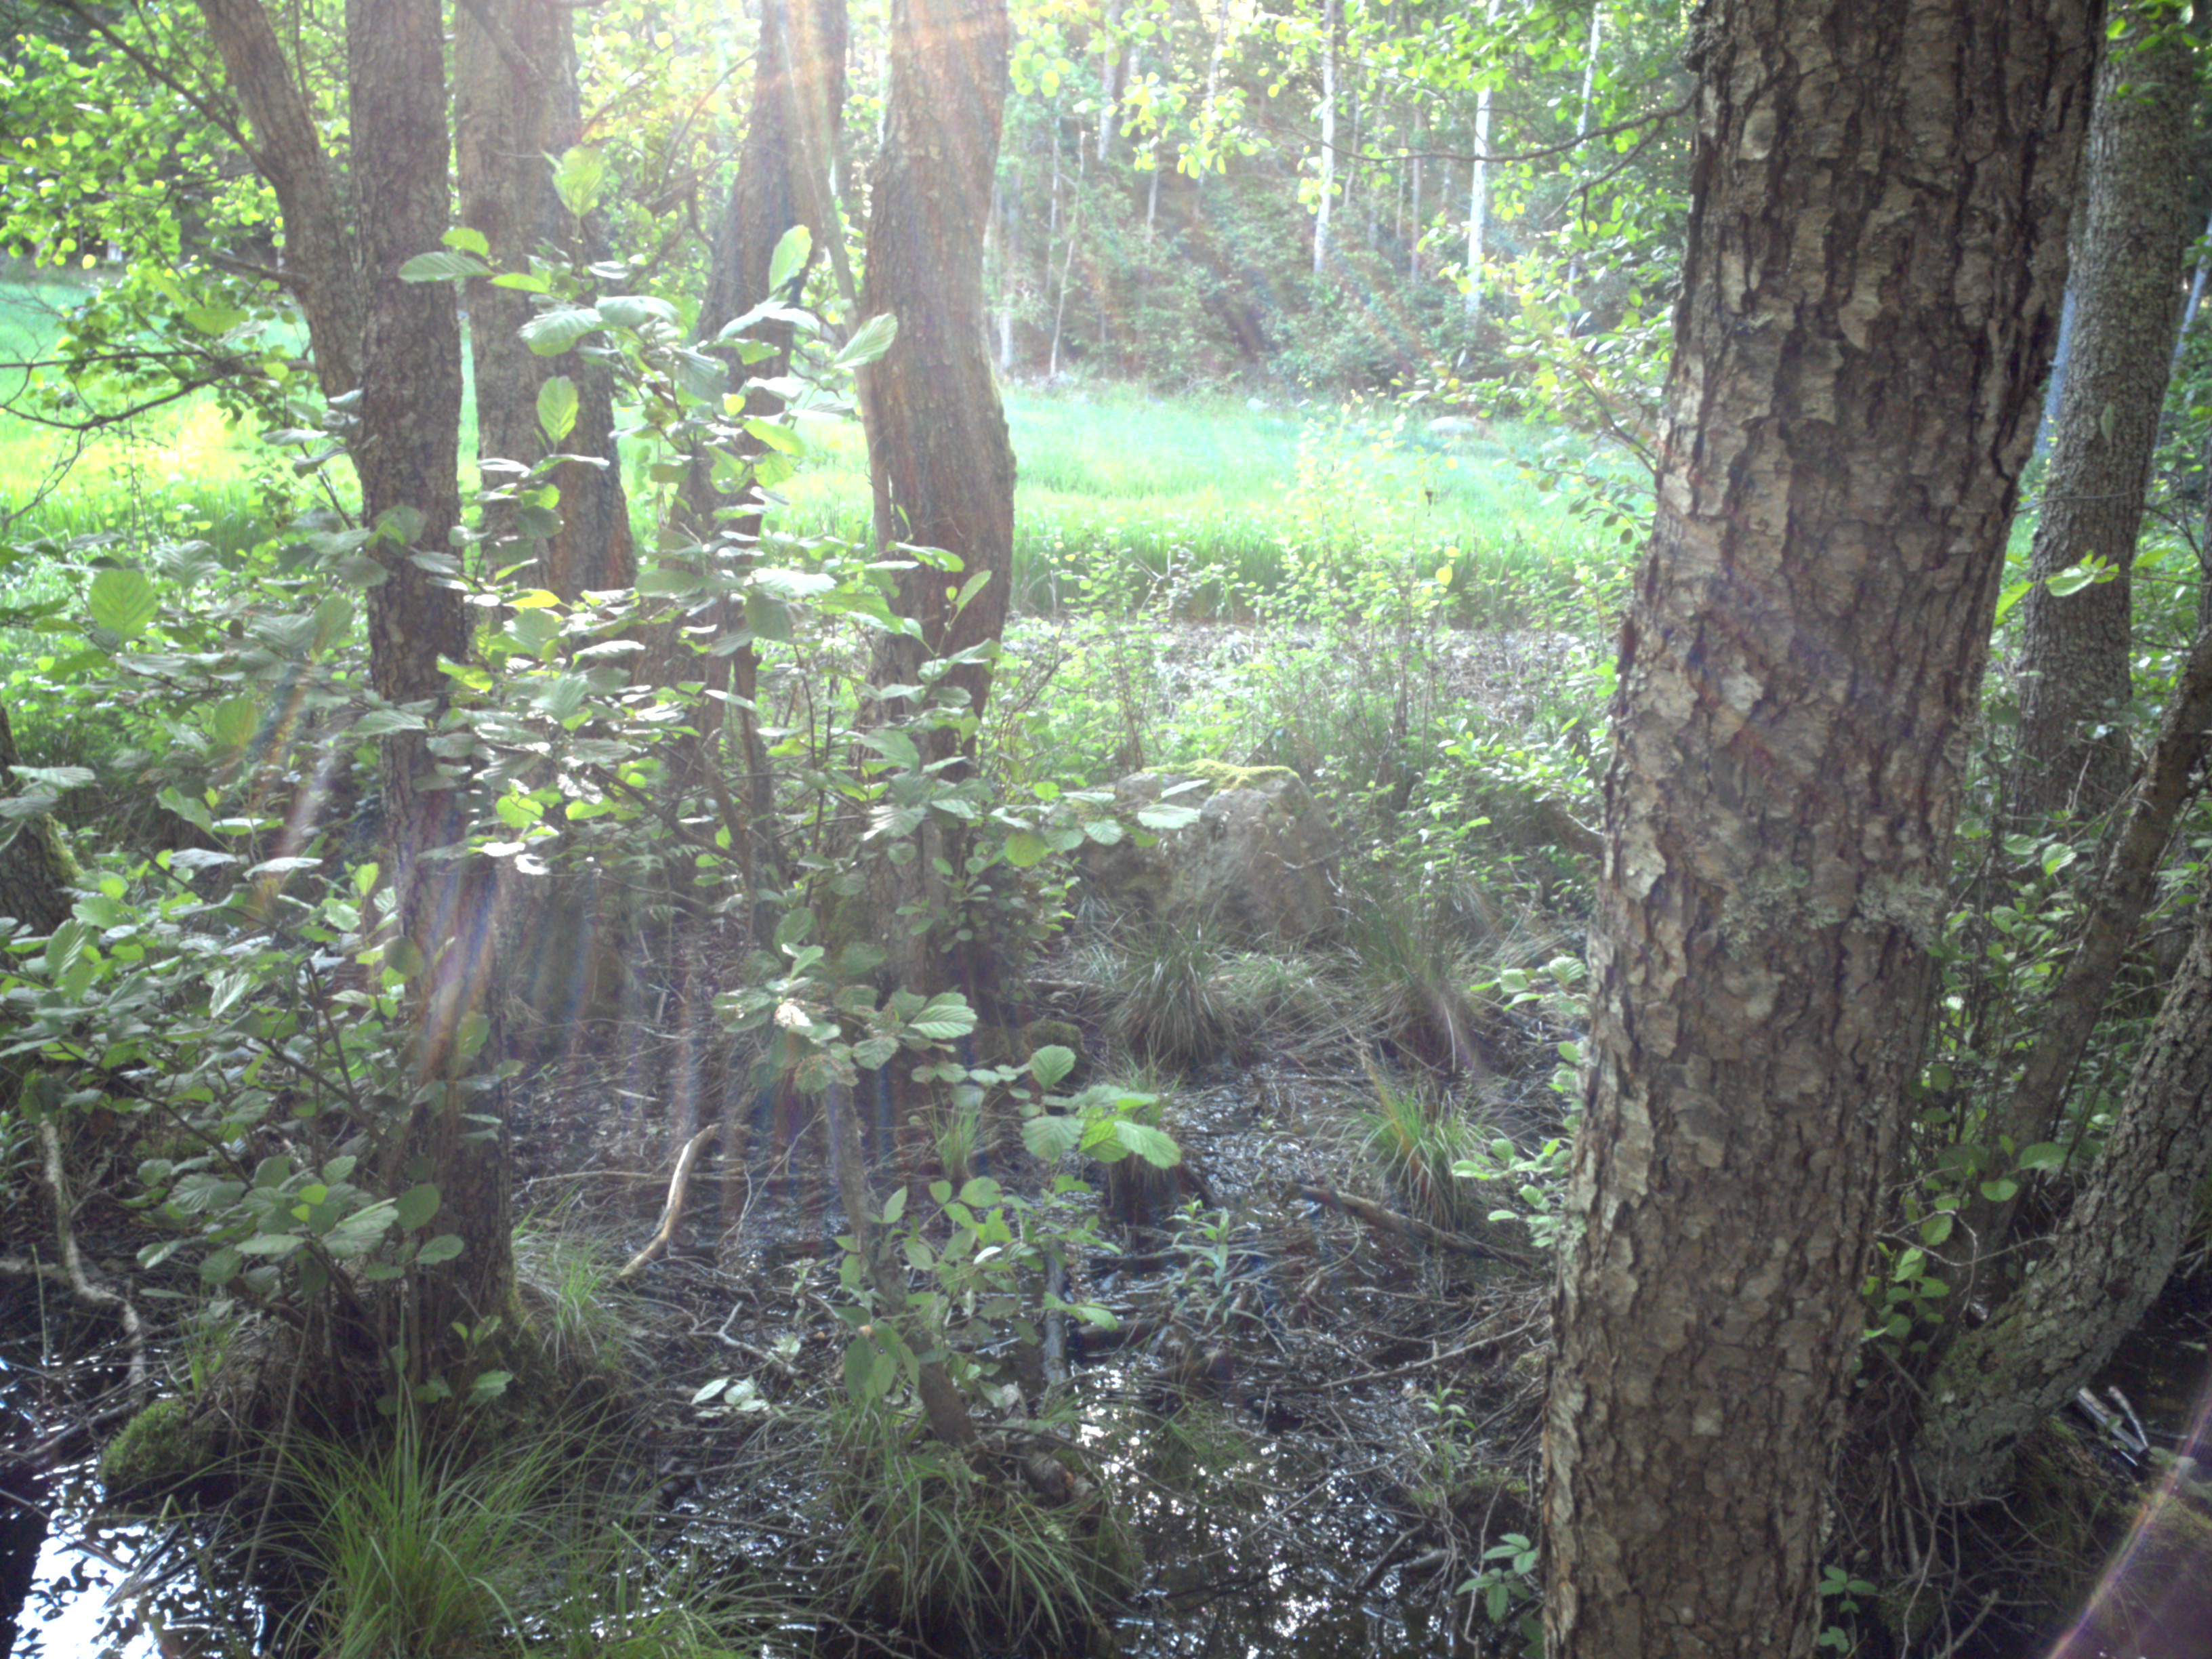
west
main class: Woodland
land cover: Broadleaved woodland
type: mire and swamp forests
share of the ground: > 75 %
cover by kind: broadleaved forest trees 90 %
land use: Semi-natural and natural areas not in use
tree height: > 5 m
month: June
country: SE
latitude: 59.2244
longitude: 17.4431
